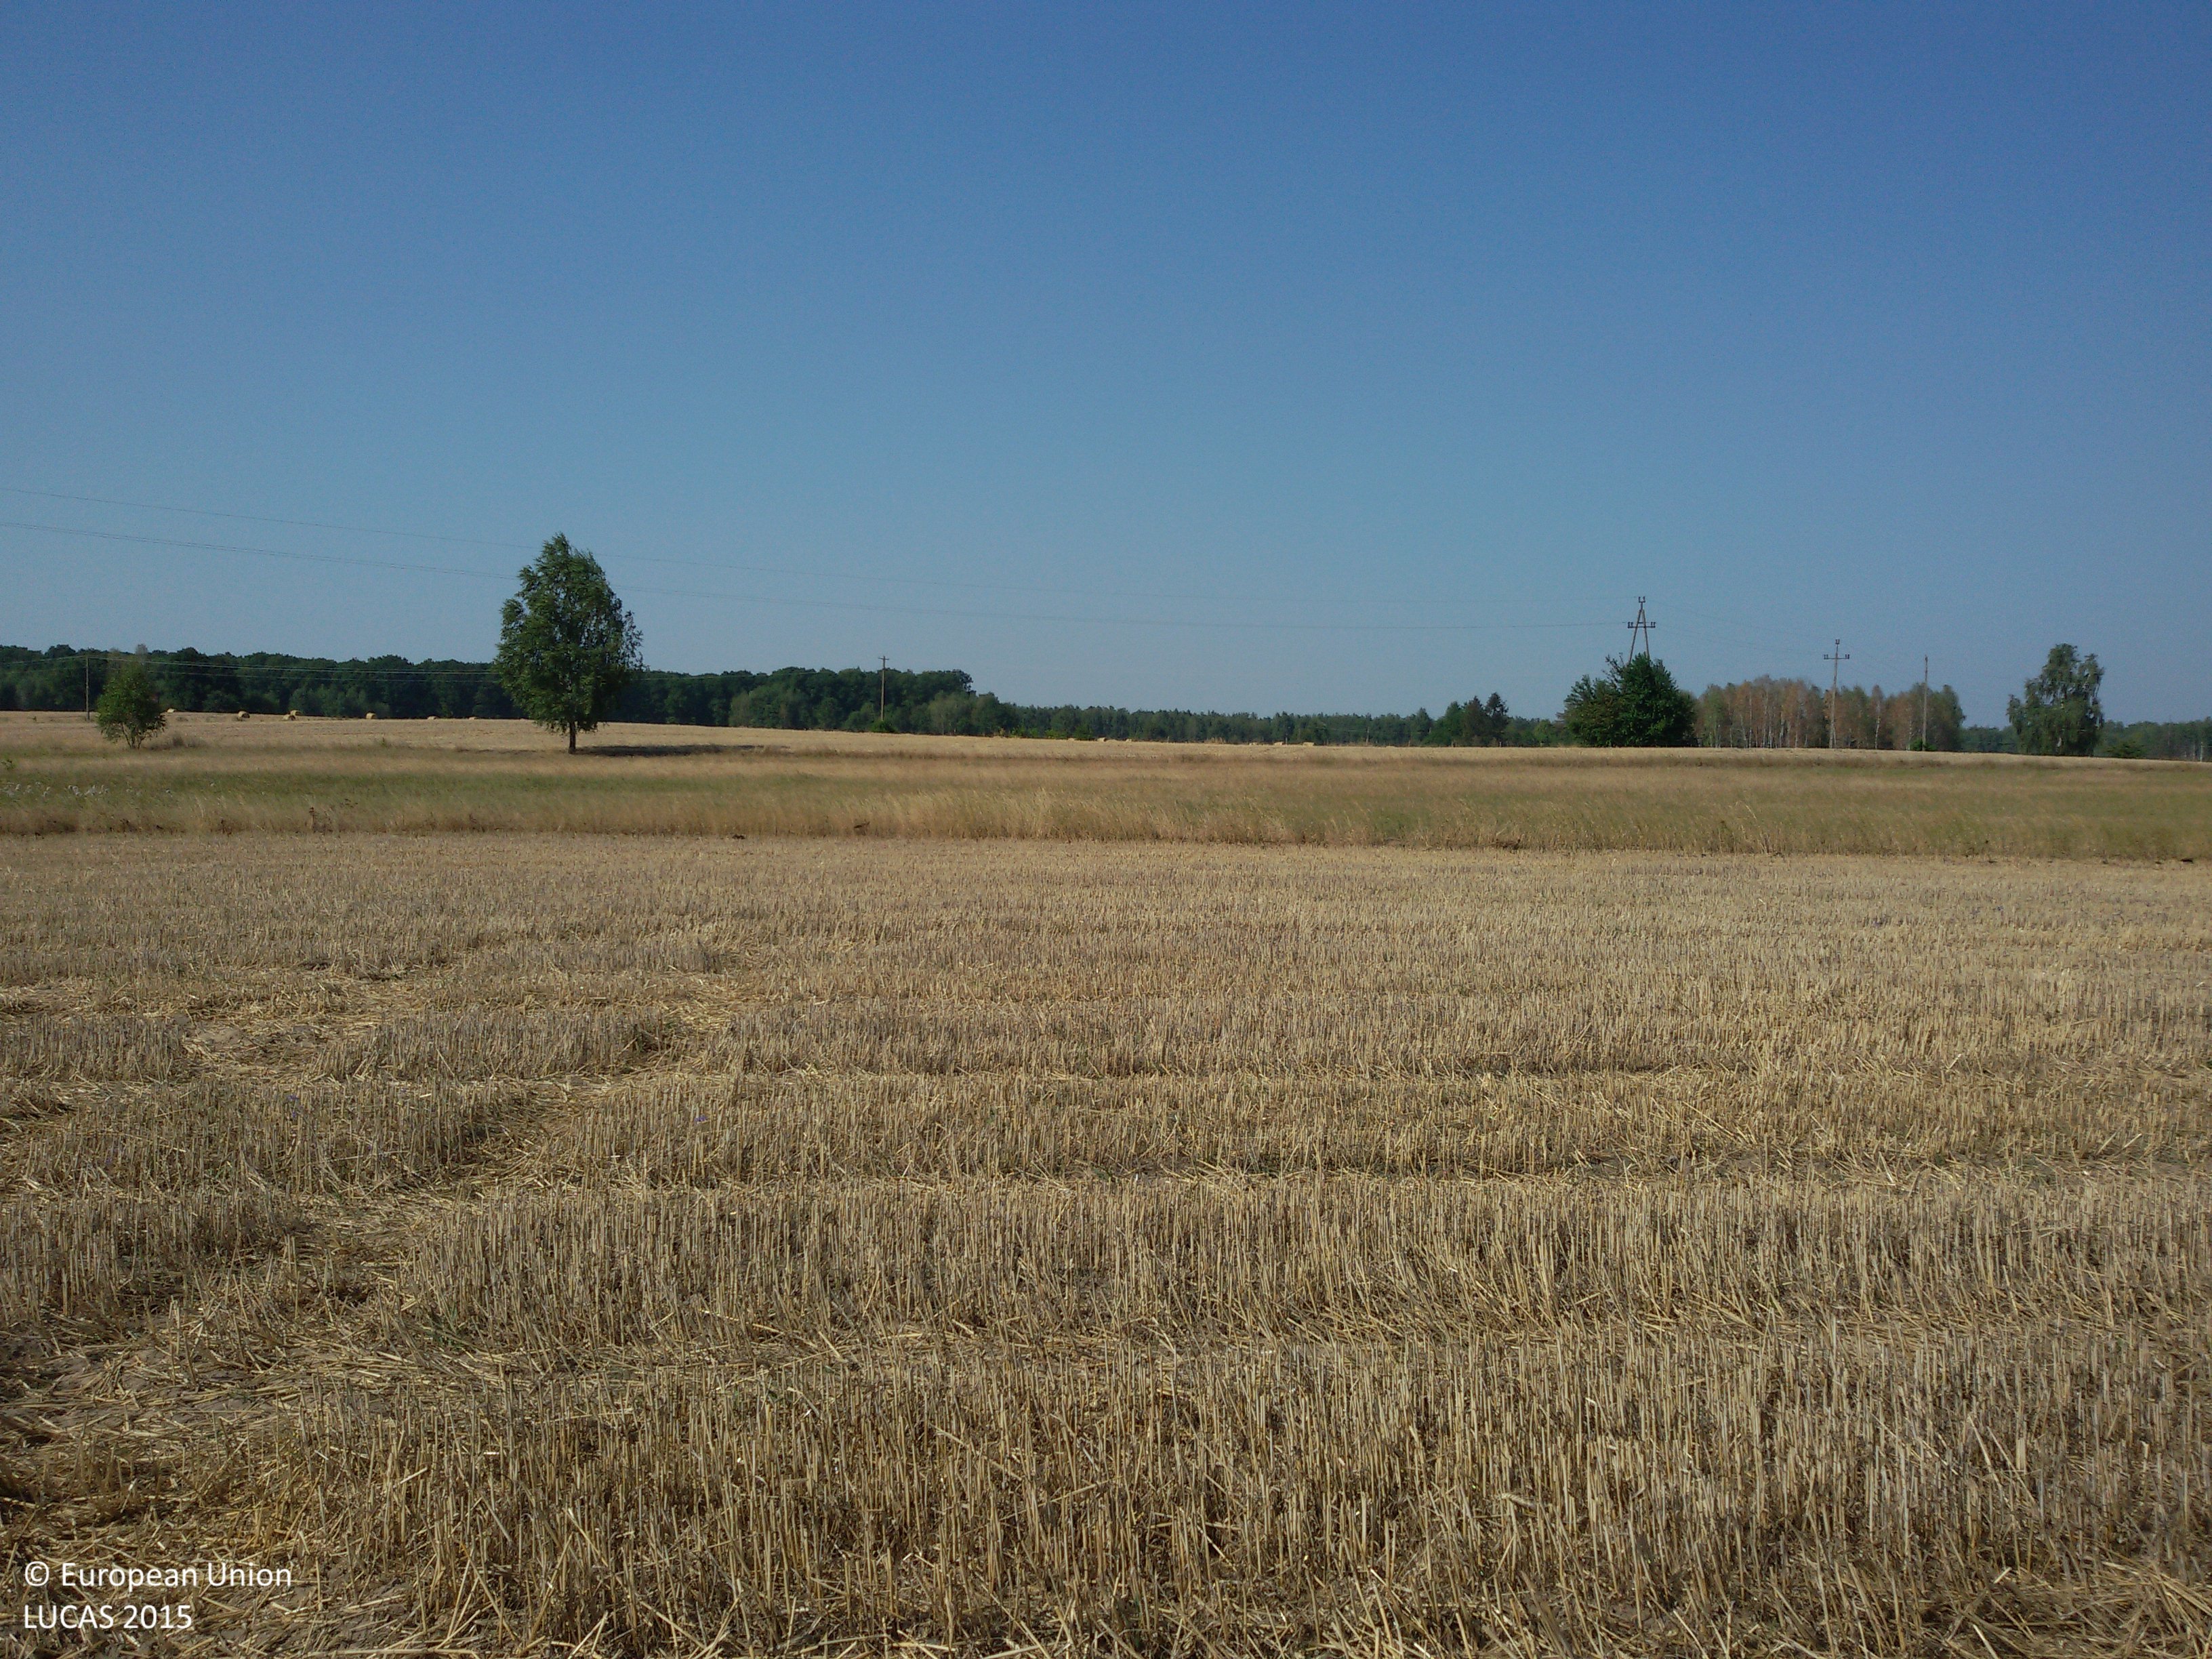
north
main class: Cropland
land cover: Rye
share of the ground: 50 - 75 %
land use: Agriculture (excluding fallow land and kitchen gardens)
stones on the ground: < 10 %
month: August
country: PL
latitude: 51.3167
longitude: 23.4411
